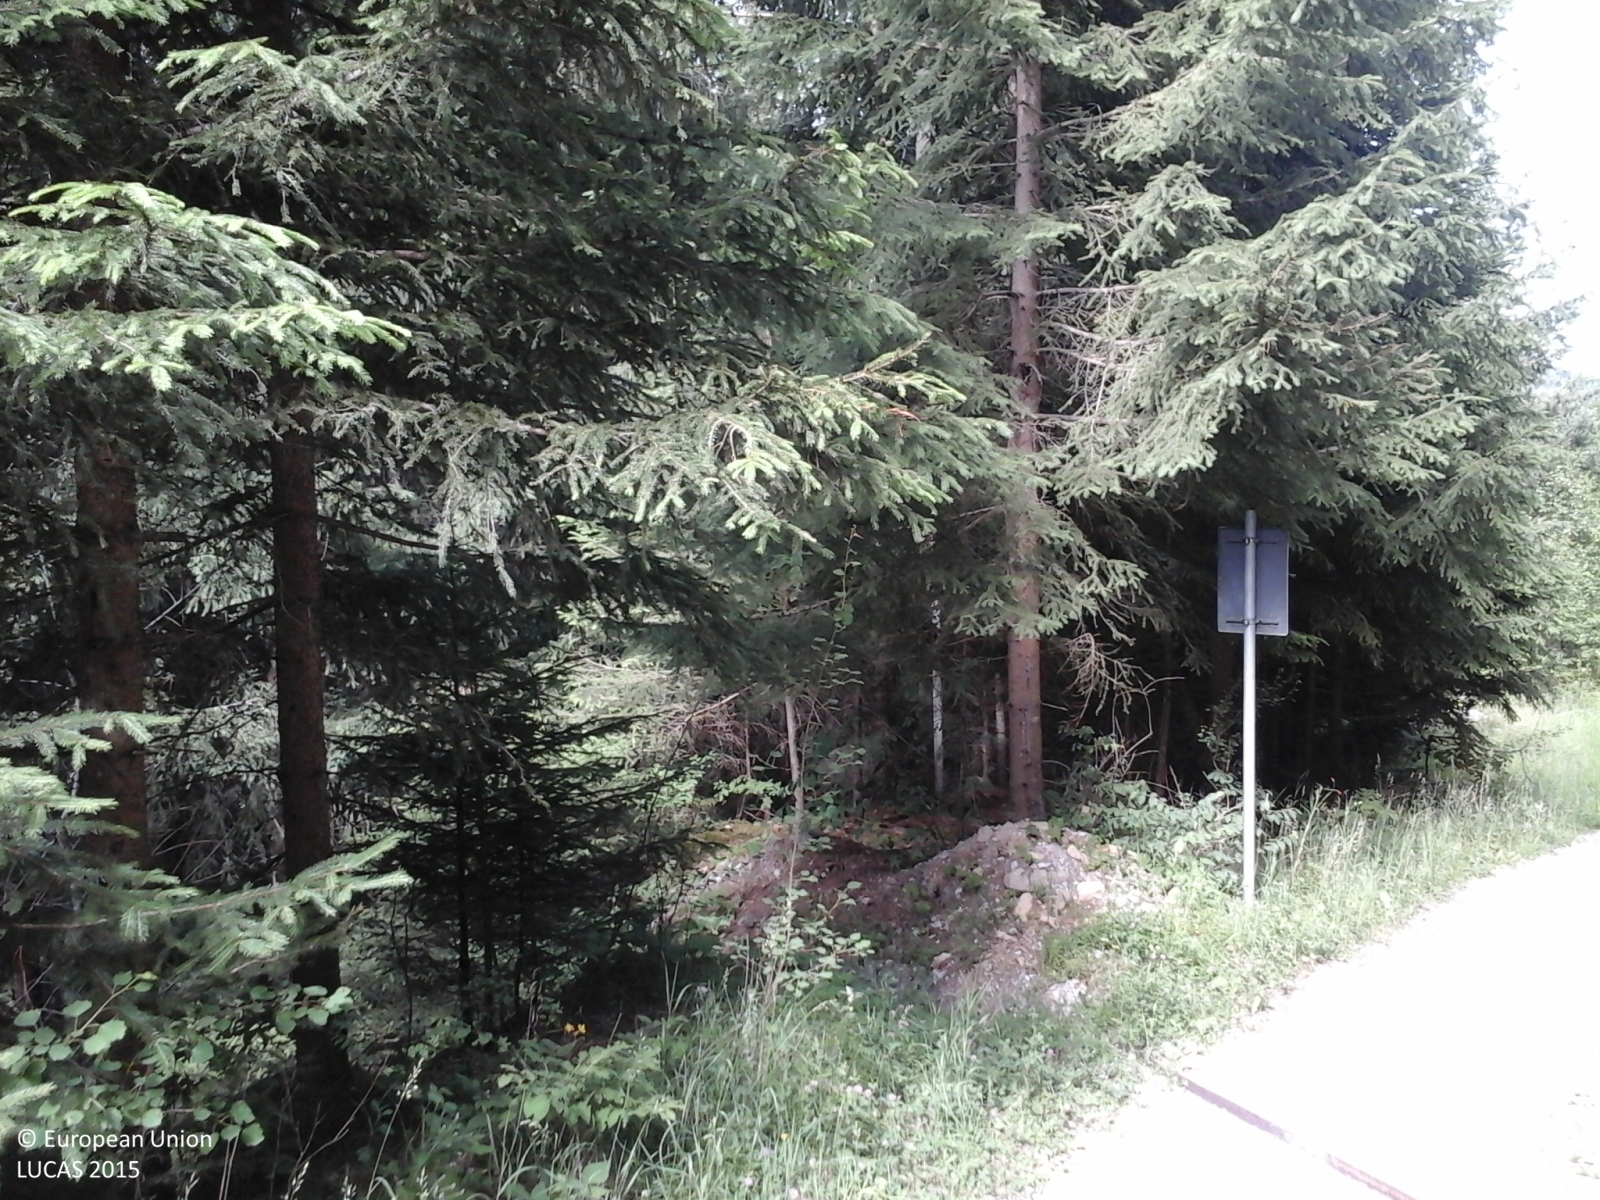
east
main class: Woodland
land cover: Spruce dominated coniferous woodland
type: alpine coniferous forest
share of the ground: > 75 %
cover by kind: coniferous forest trees 100 %
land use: Forestry
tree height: > 5 m
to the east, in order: Spruce dominated coniferous woodland; Grassland without tree/shrub cover; Spruce dominated coniferous woodland; Tracks; Spruce dominated coniferous woodland
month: June
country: IT
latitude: 46.7718
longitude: 11.5829
